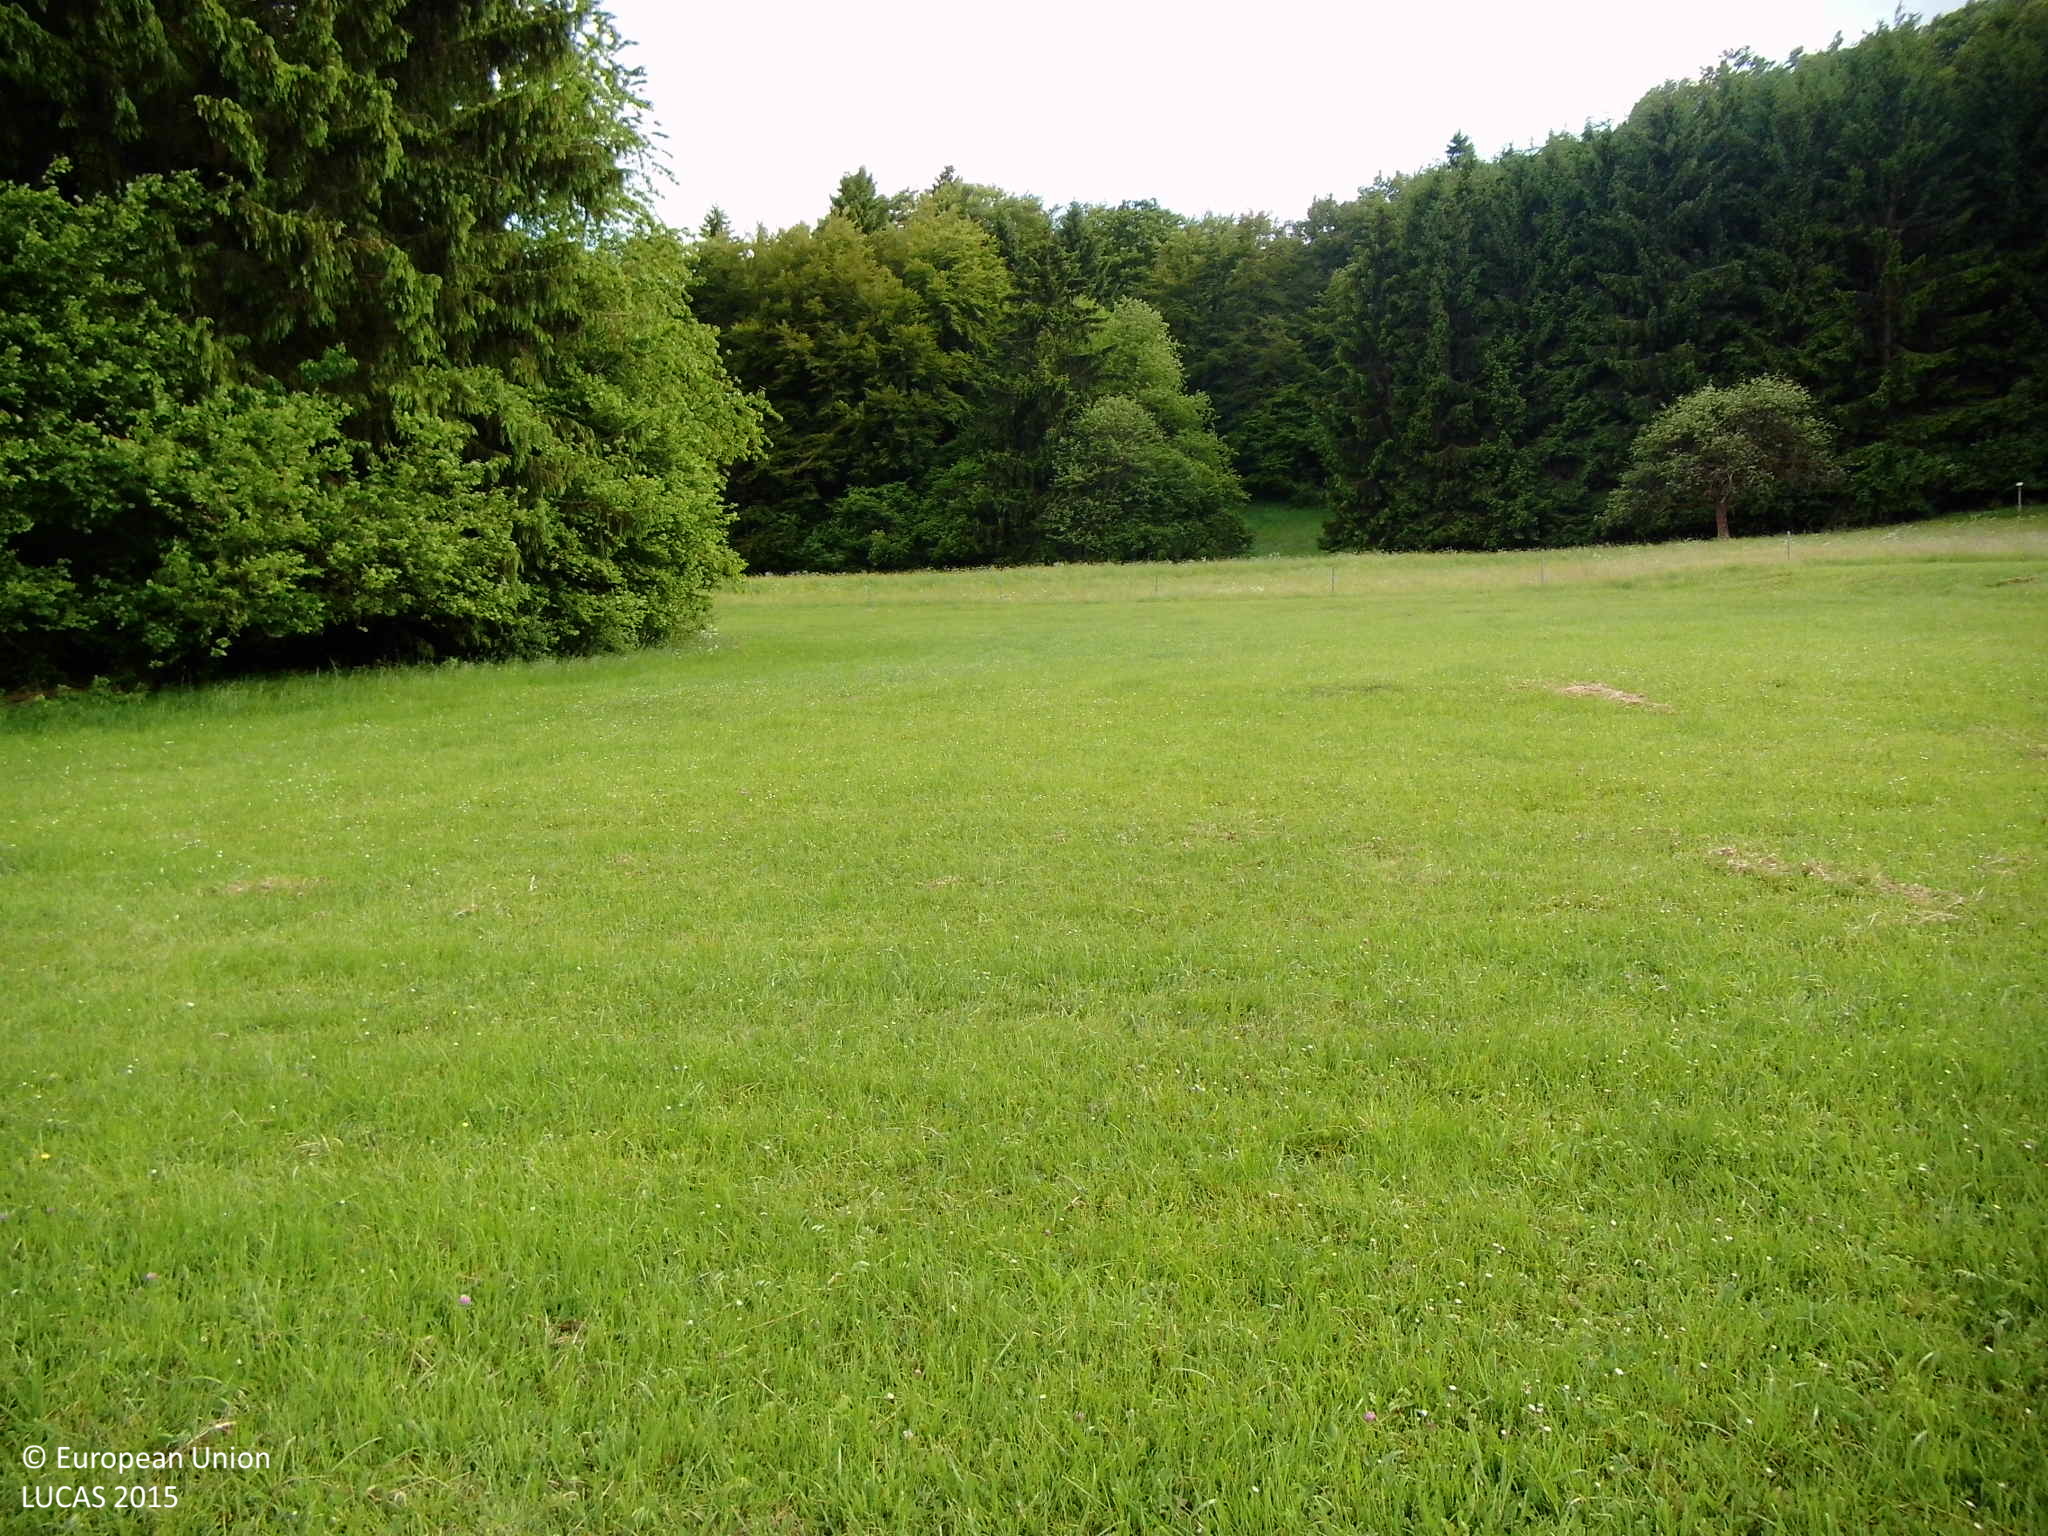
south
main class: Cropland
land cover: Apple fruit
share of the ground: 10 - 25 %
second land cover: Grassland without tree/shrub cover
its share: > 75 %
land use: Agriculture (excluding fallow land and kitchen gardens)
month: June
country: DE
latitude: 50.8028
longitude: 8.4253
